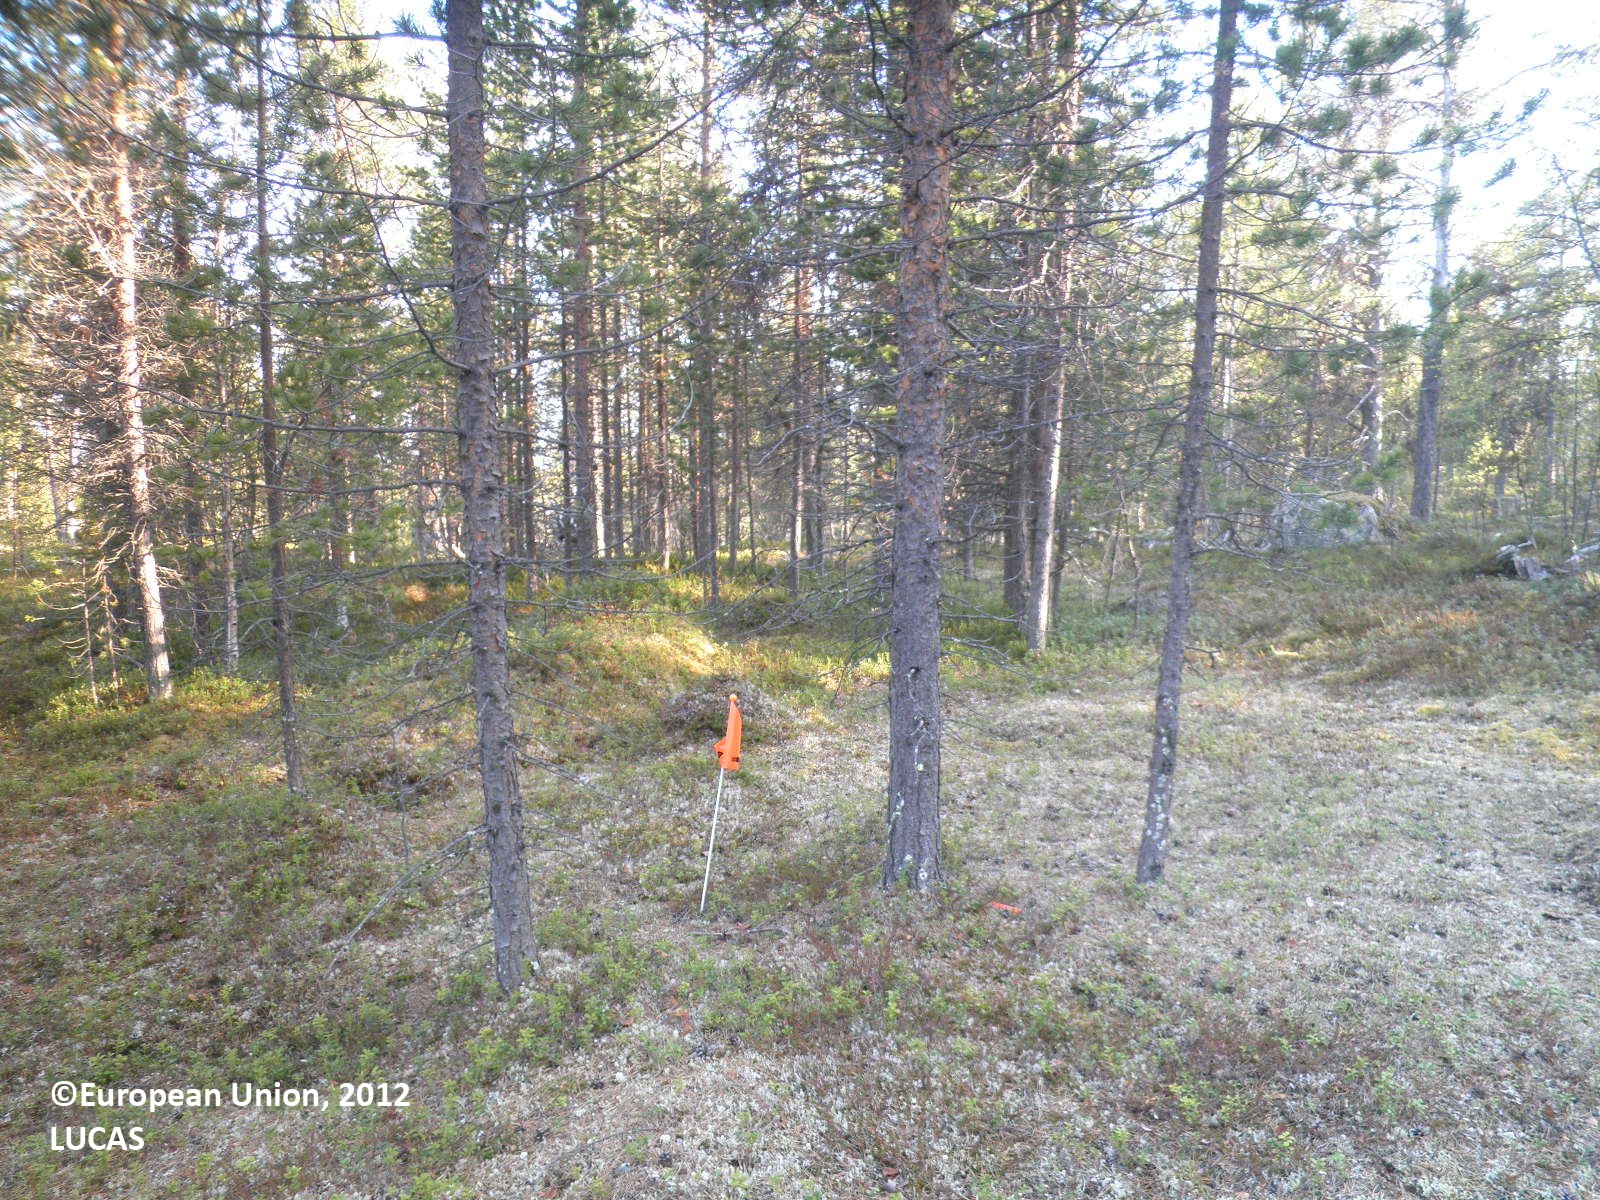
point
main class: Woodland
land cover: Pine dominated coniferous woodland
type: boreal forest
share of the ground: > 75 %
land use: Forestry
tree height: > 5 m
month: June
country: FI
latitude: 69.0712
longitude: 27.5034
